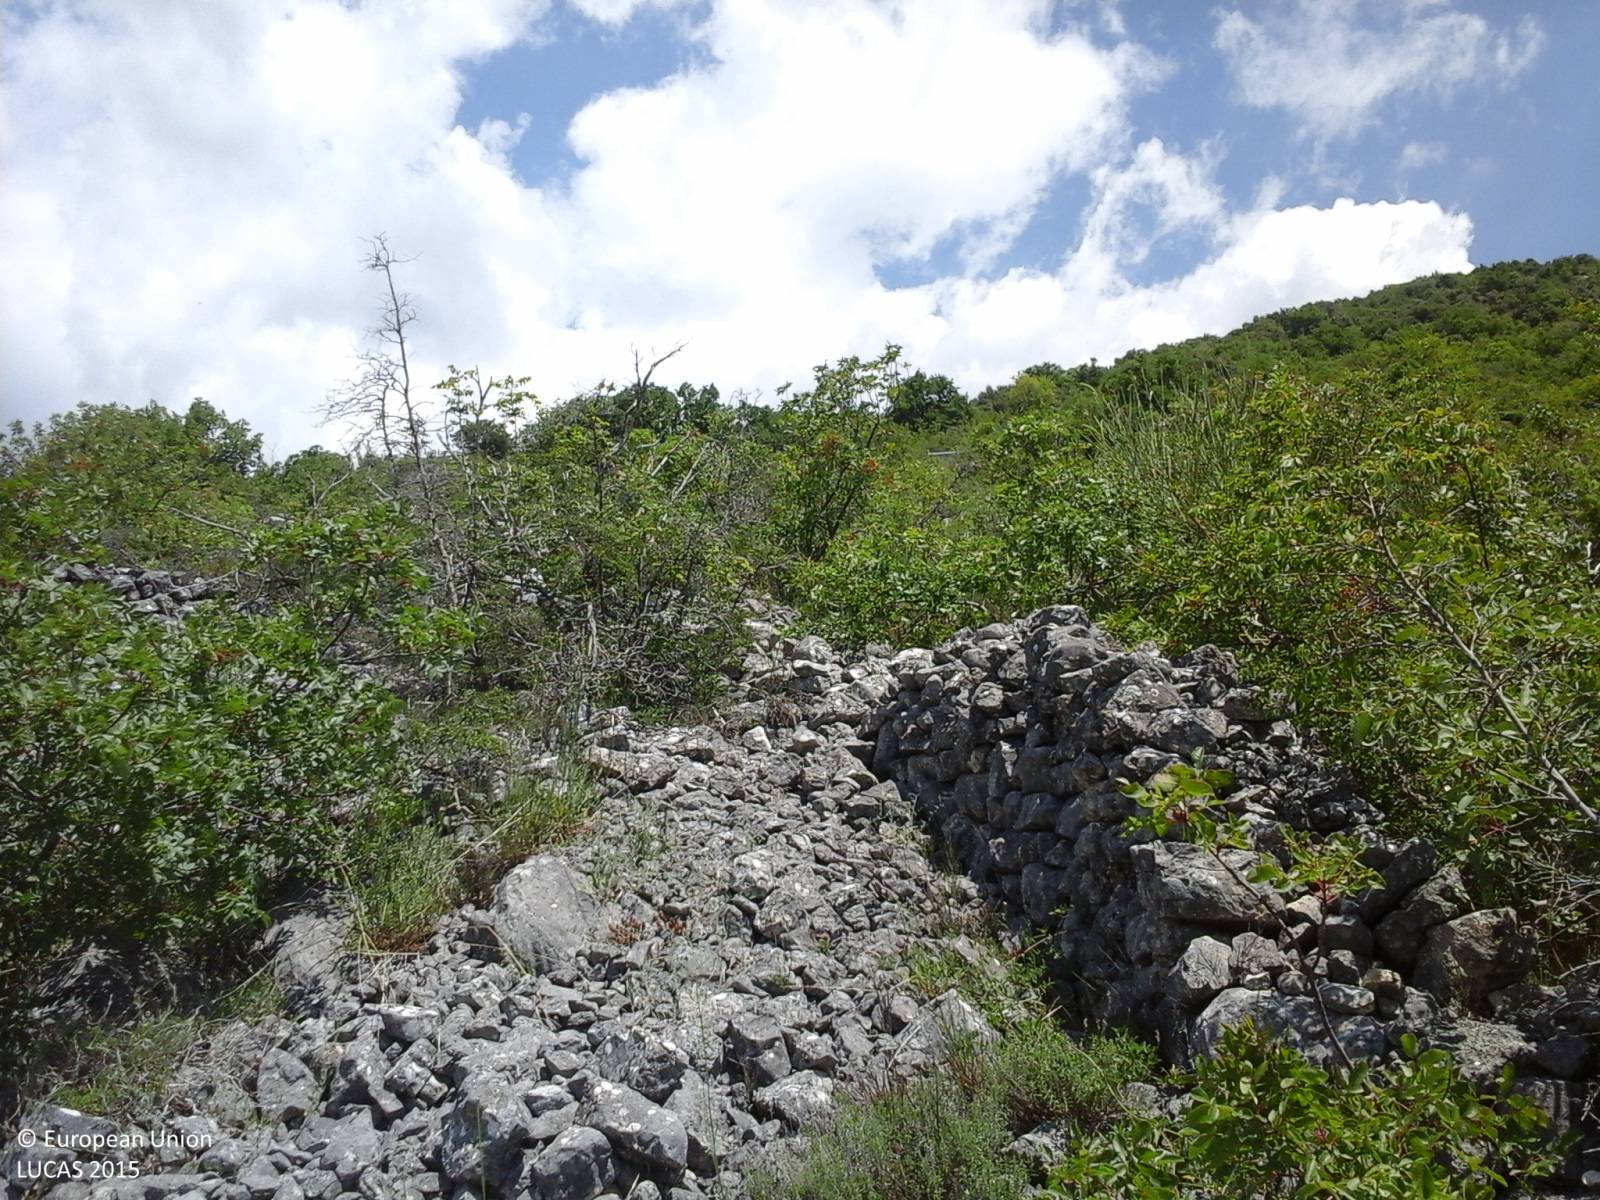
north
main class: Shrubland
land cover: Shrubland without tree cover
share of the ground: 50 - 75 %
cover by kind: shrubs 60 %, unconsolidated bare surface 35 %, herbaceous plants 5 %
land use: Semi-natural and natural areas not in use
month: June
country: IT
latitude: 42.3121
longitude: 13.7854
